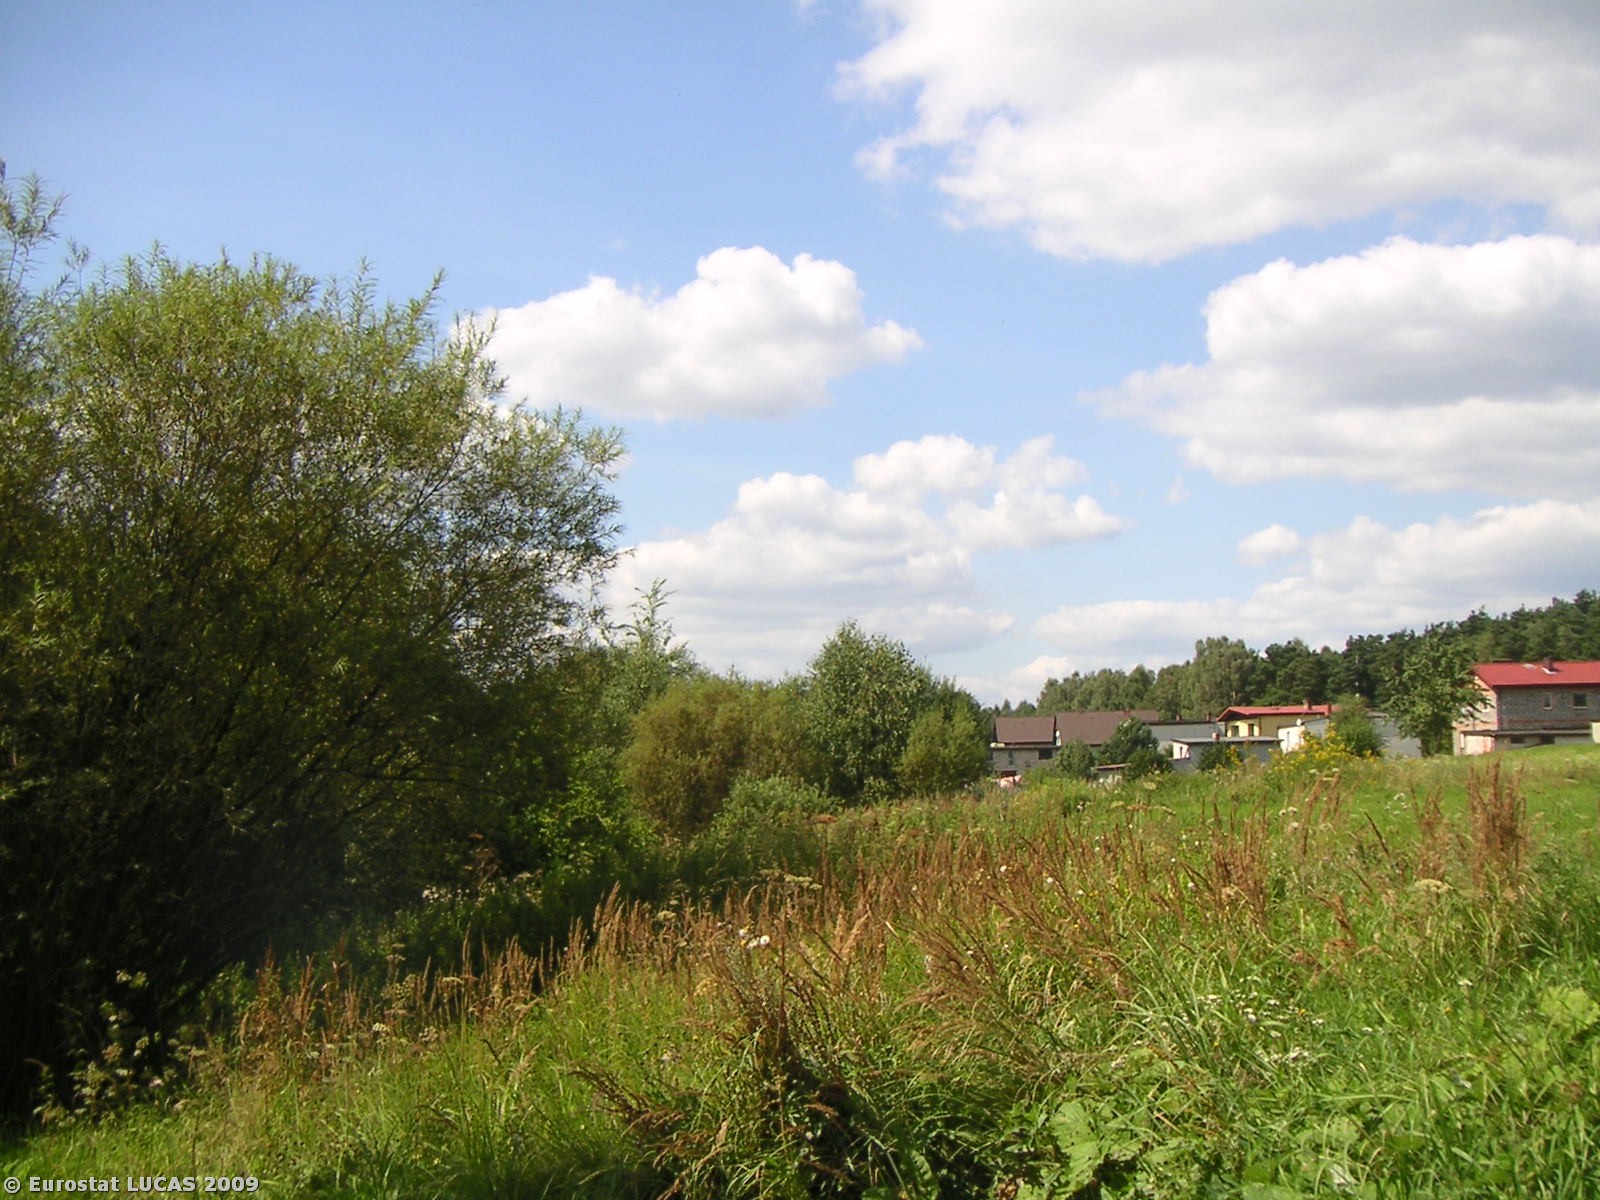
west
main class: Grassland
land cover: Spontaneously vegetated surfaces
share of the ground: > 75 %
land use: Fallow land
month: August
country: PL
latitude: 50.4922
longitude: 18.8318
